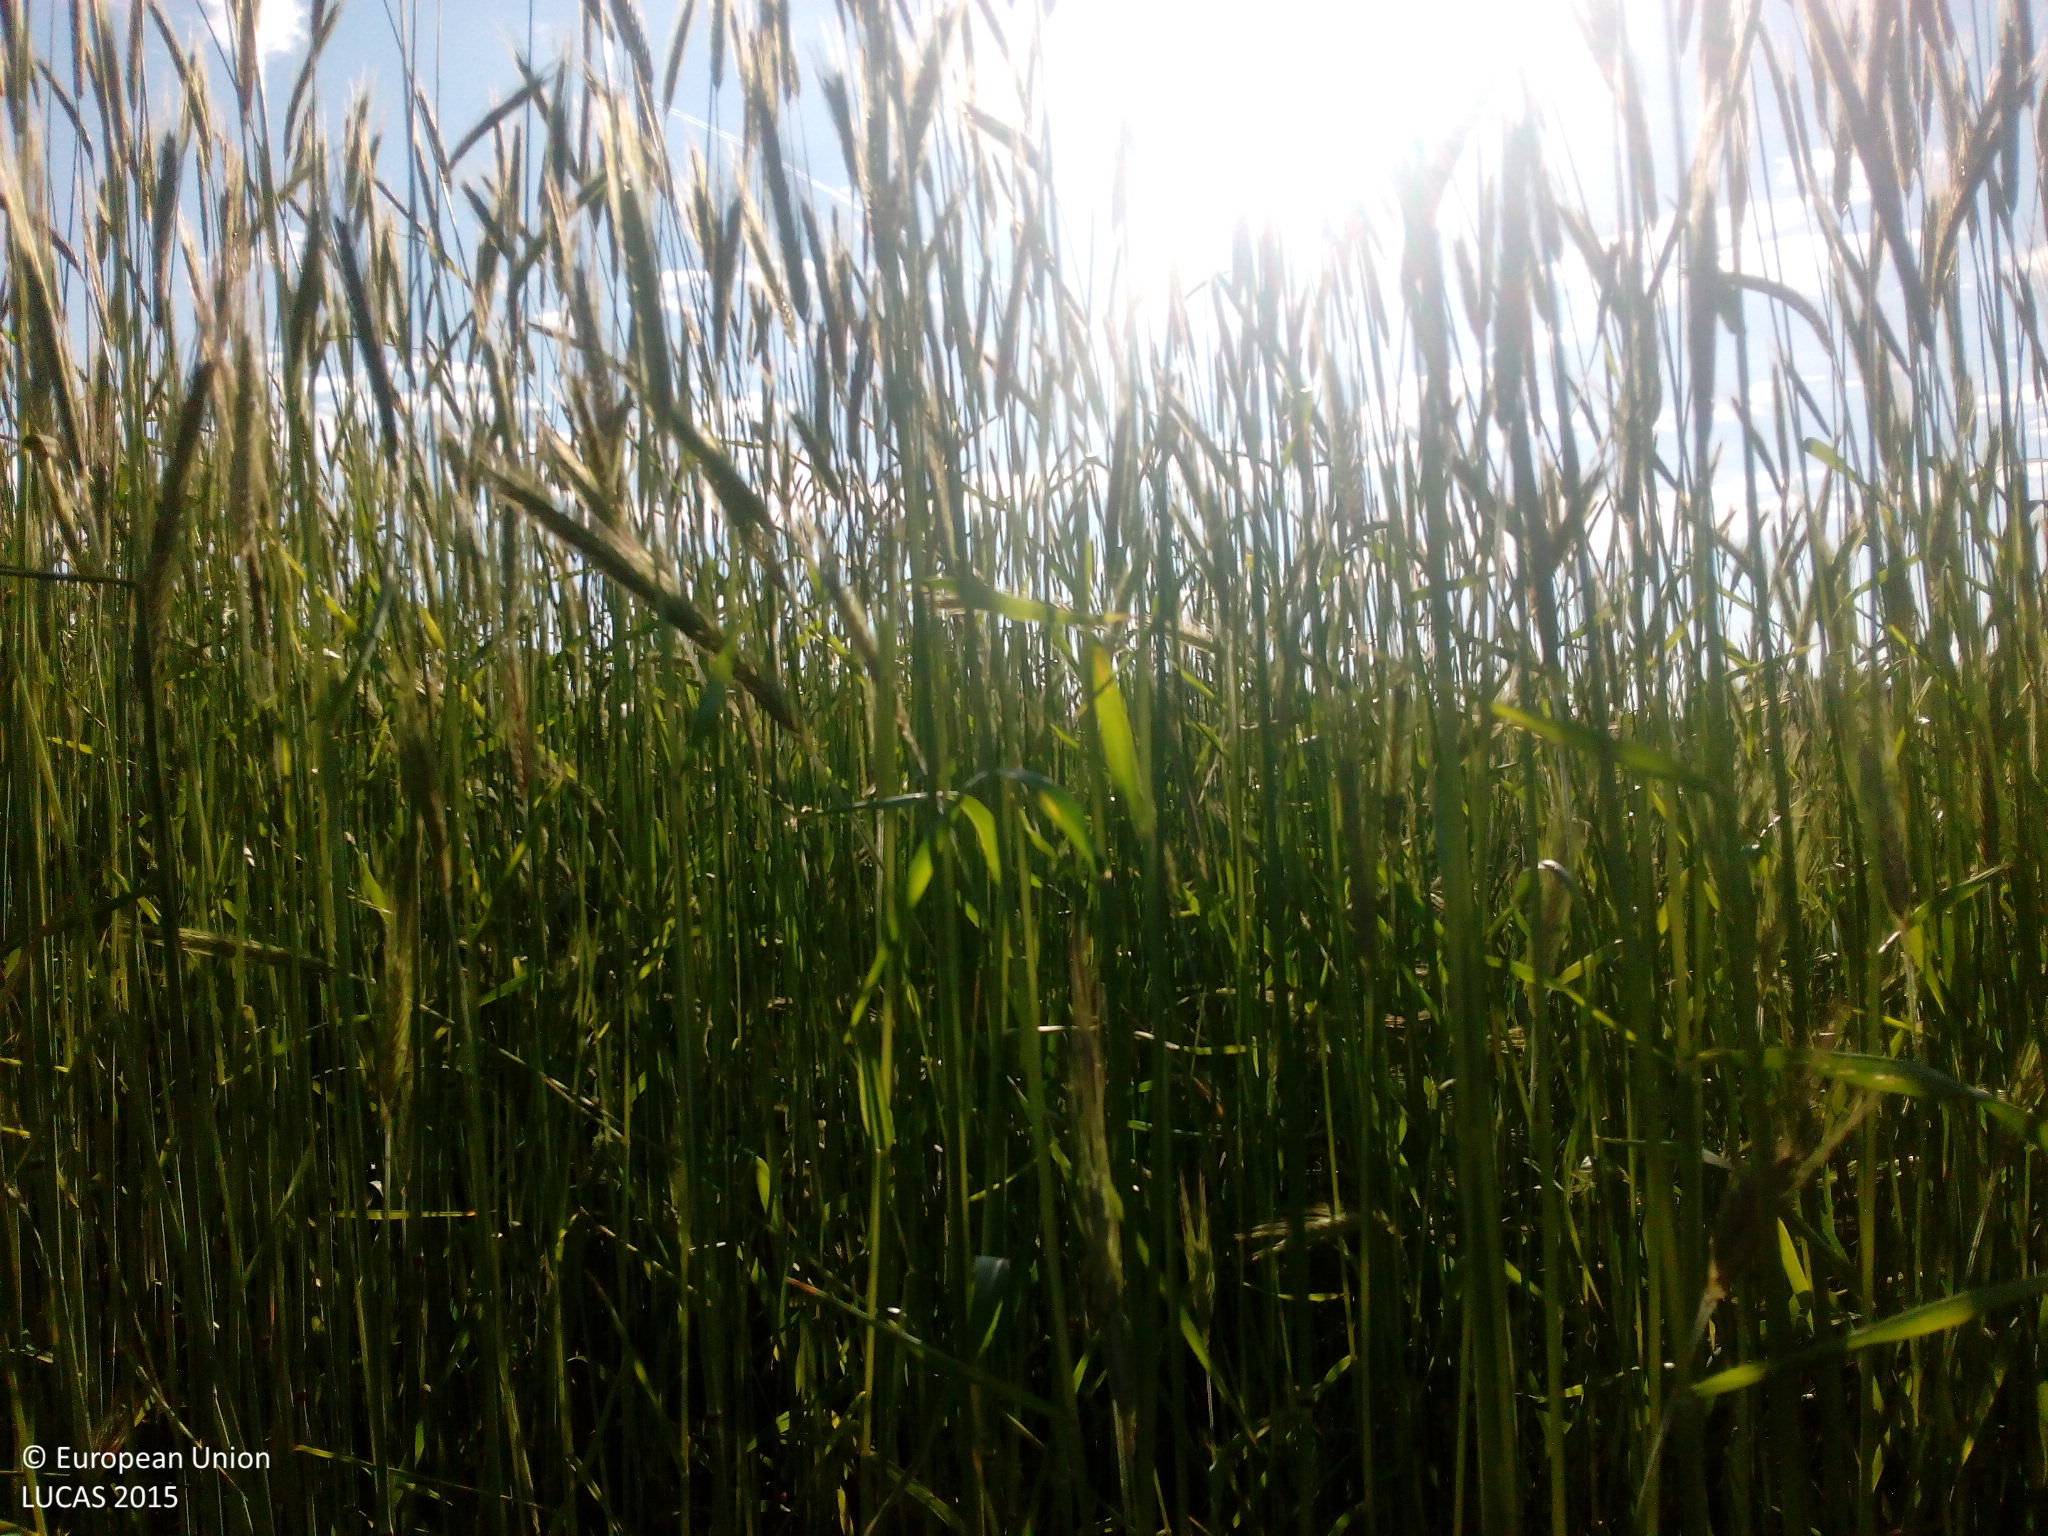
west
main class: Cropland
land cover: Rye
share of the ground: > 75 %
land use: Agriculture (excluding fallow land and kitchen gardens)
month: June
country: DE
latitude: 49.3503
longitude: 12.3535
